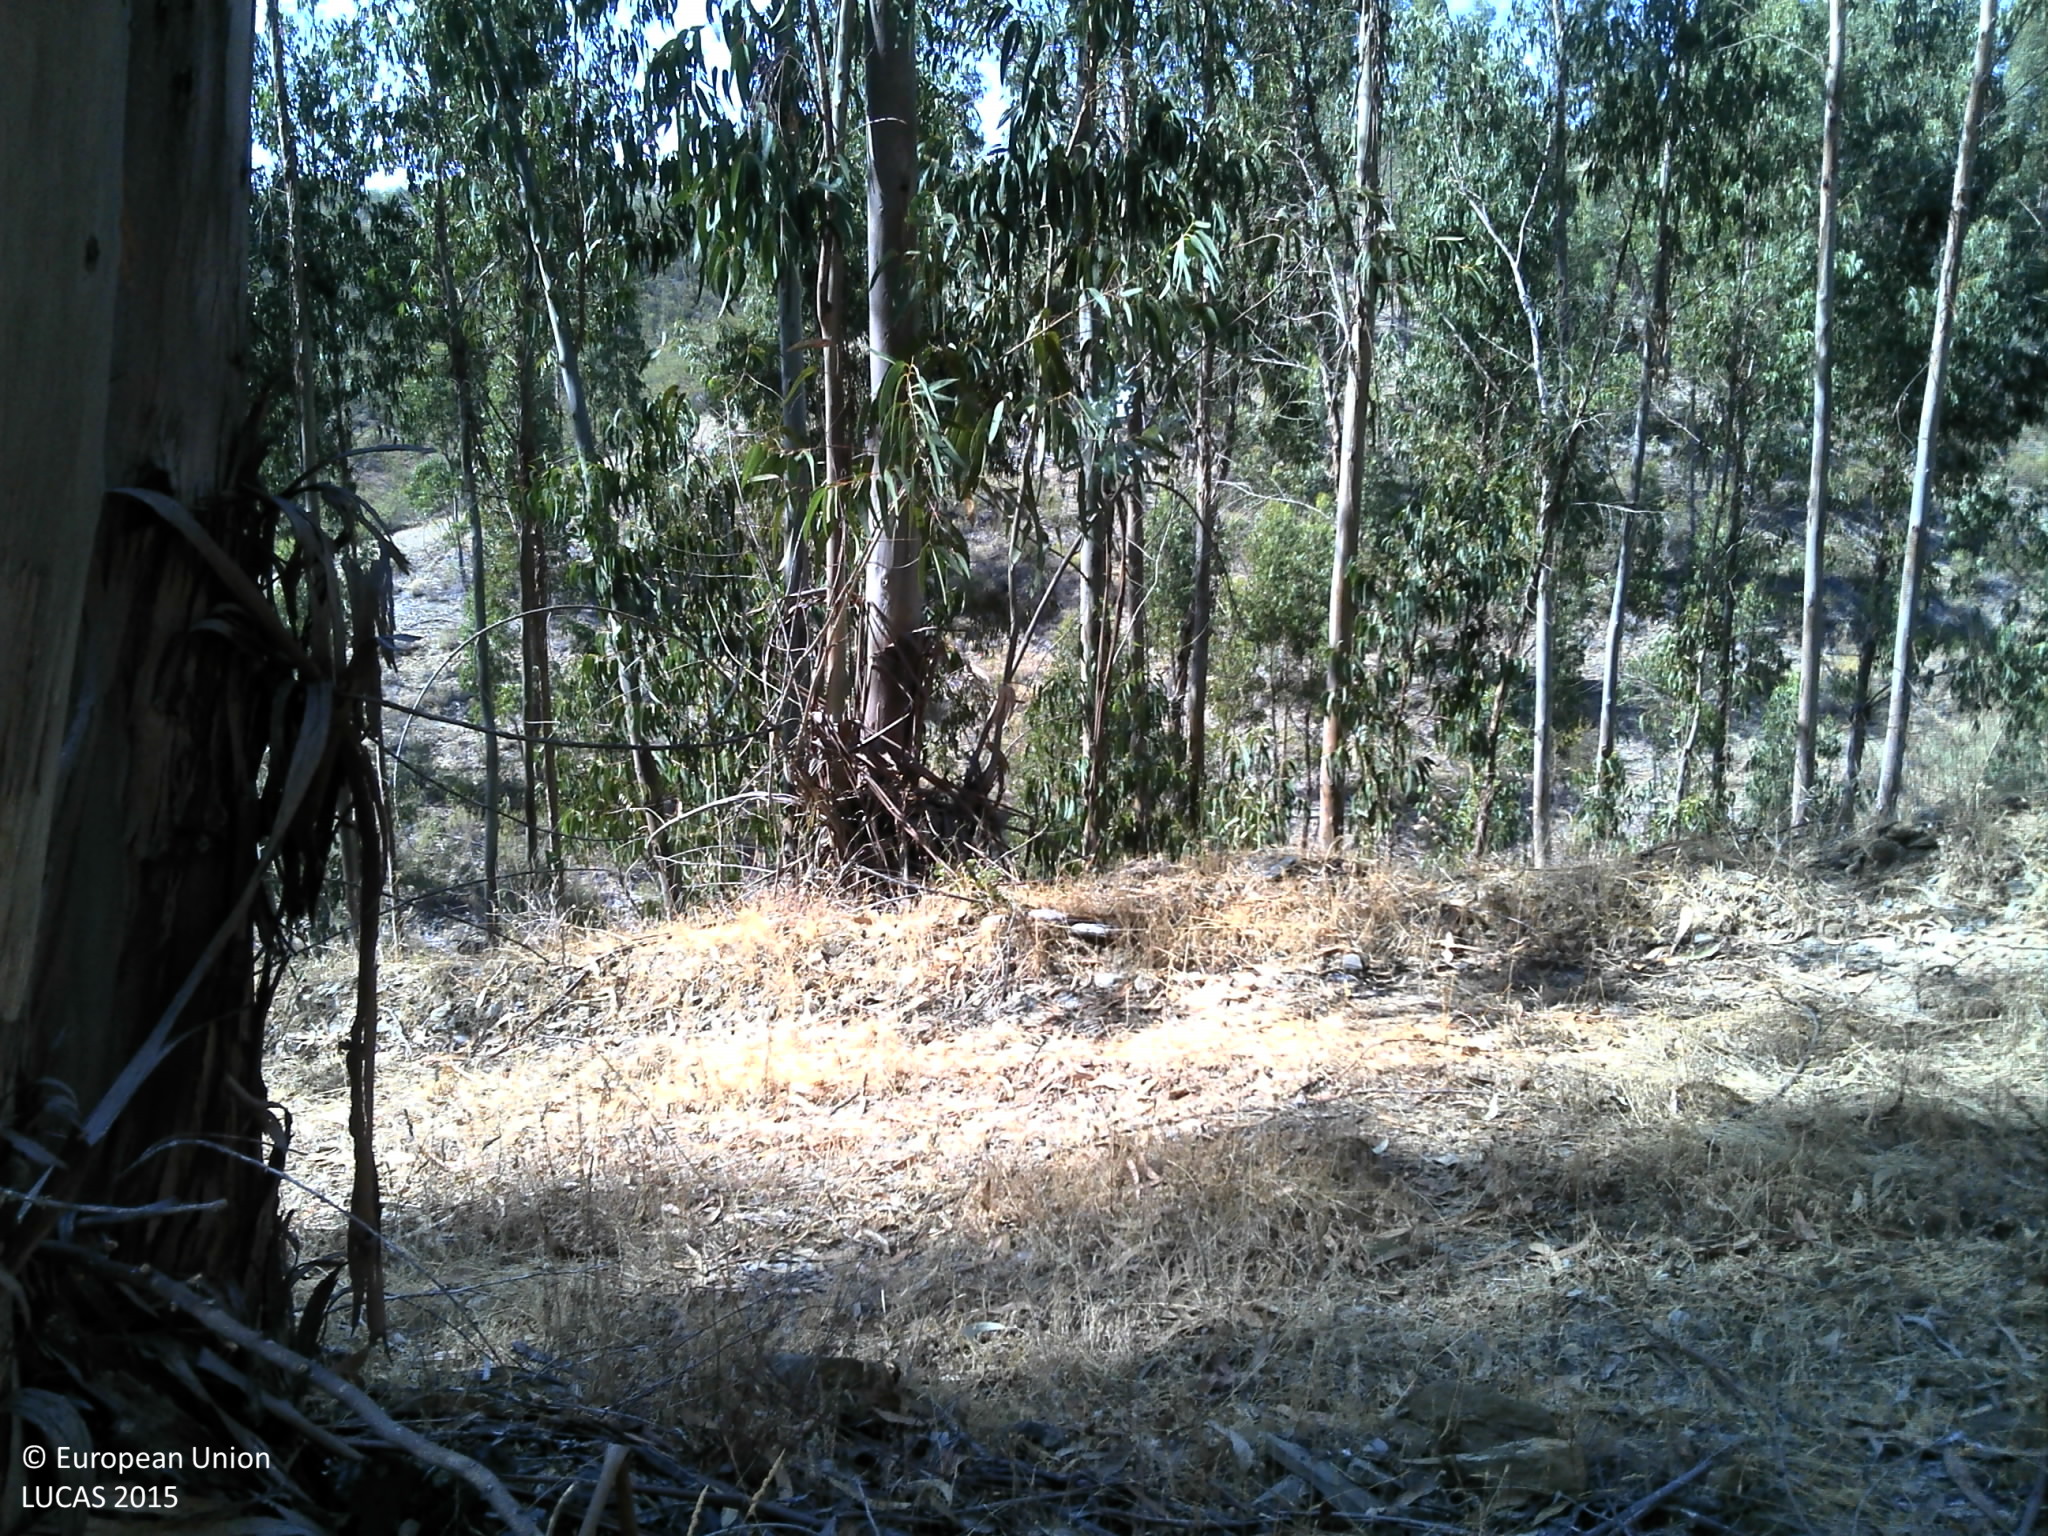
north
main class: Woodland
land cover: Broadleaved woodland
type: exotic forest
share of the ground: 10 - 25 %
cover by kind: unconsolidated bare surface 50 %, consolidated bare surface 20 %, broadleaved forest trees 15 %, shrubs 15 %
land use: Forestry
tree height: > 5 m
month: July
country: PT
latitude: 39.5875
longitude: -7.7886
